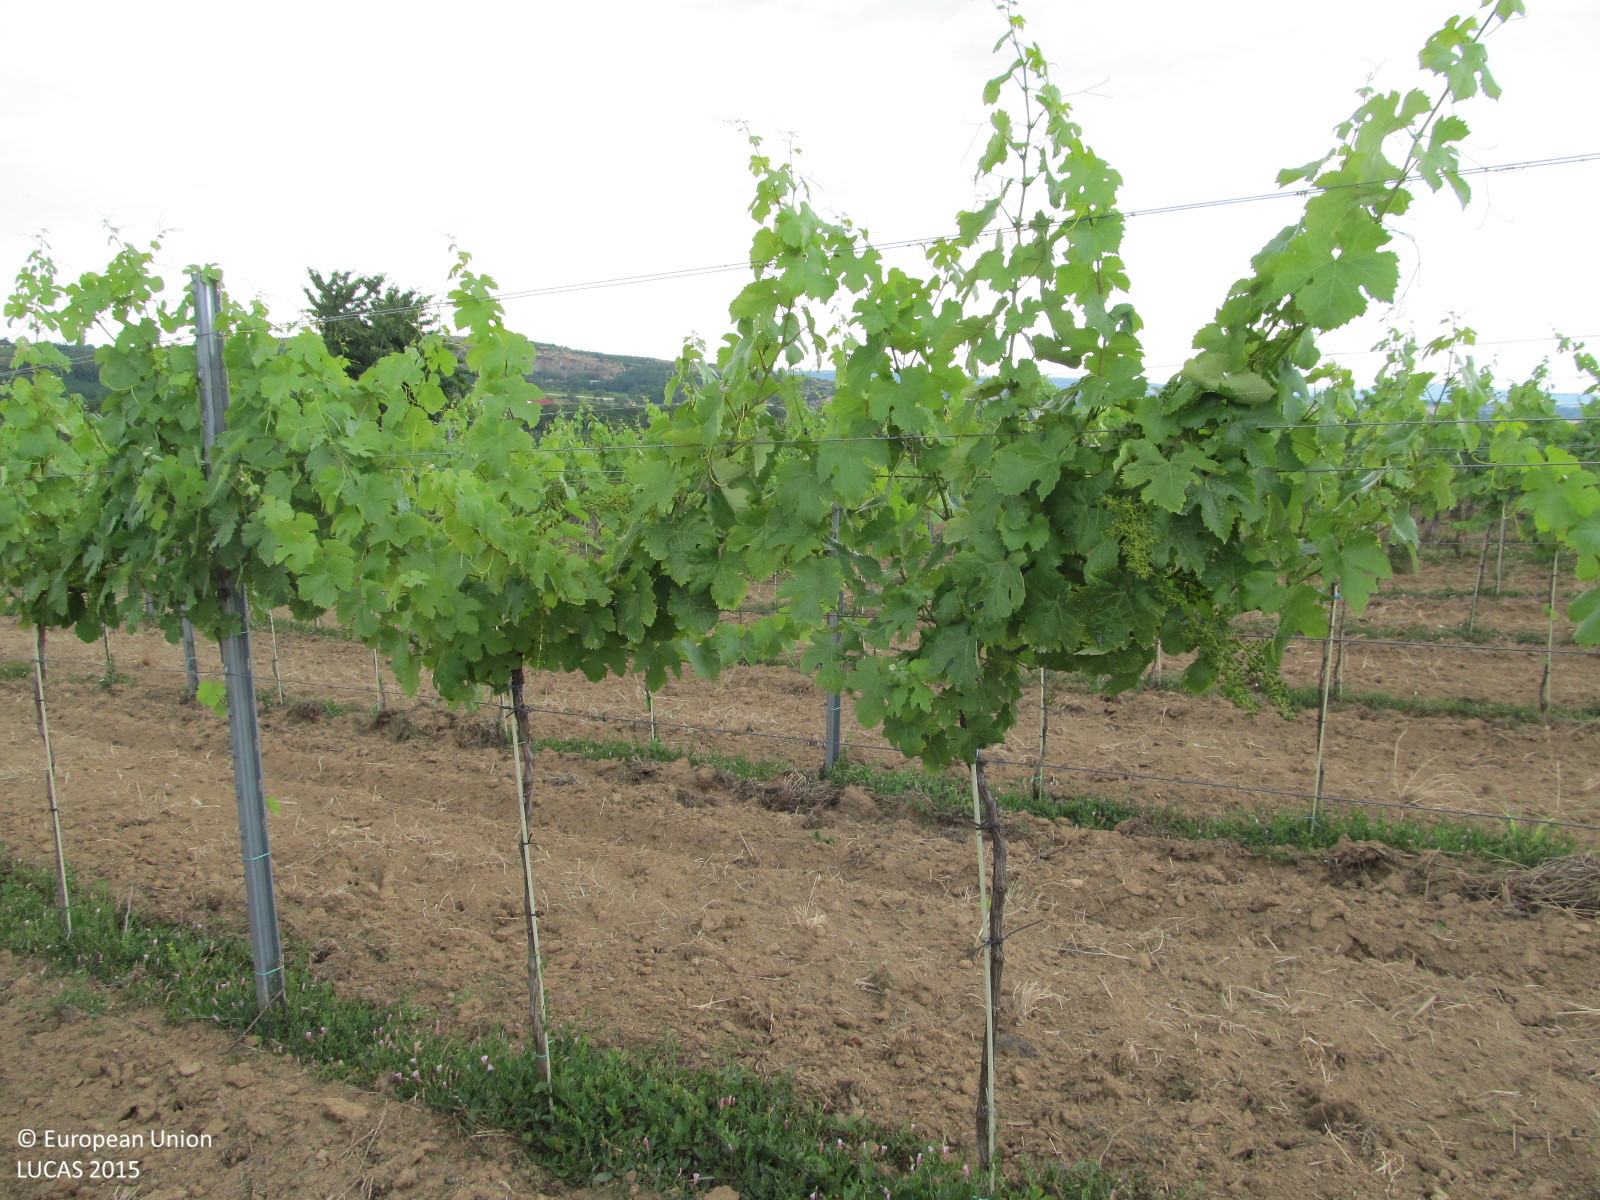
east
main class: Cropland
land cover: Vineyards
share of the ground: 25 - 50 %
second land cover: Other bare soil
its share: > 75 %
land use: Agriculture (excluding fallow land and kitchen gardens)
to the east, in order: Vineyards; Other bare soil; Grass margins; Tracks; Broadleaved woodland; Paved roads, cycling and walking lanes; Managed hedges; Other bare soil; Vineyards
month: June
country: AT
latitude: 48.7500
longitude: 15.9207
